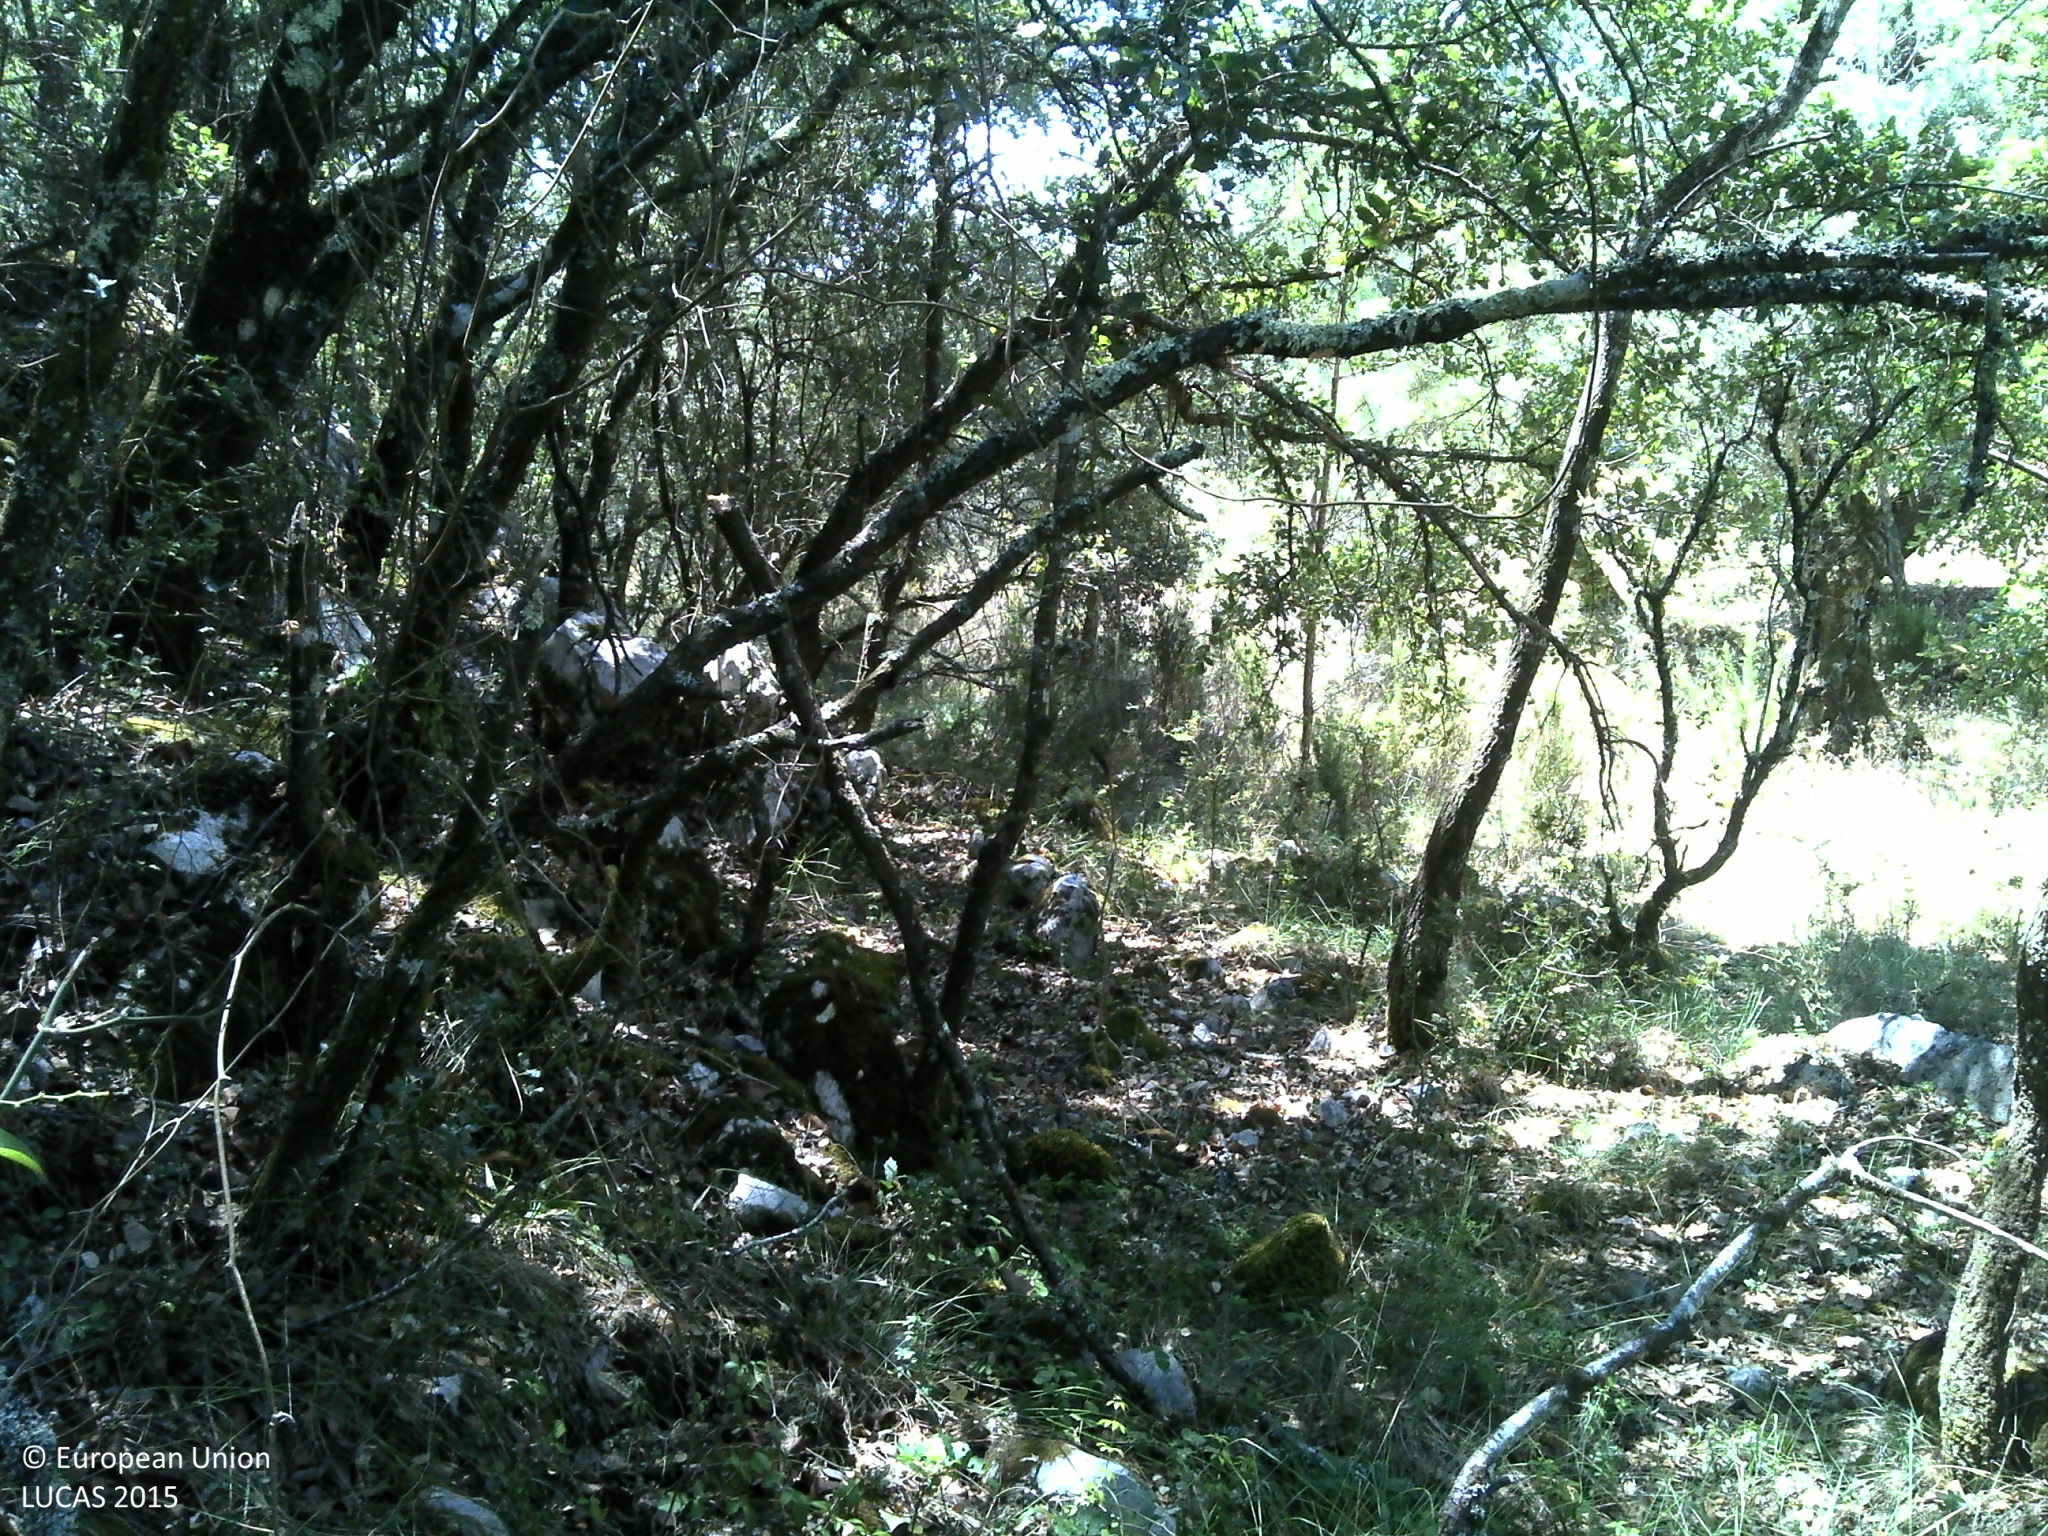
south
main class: Woodland
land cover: Broadleaved woodland
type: acidophilous oak and oak-birch forest
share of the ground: 50 - 75 %
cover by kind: broadleaved forest trees 55 %, herbaceous plants 30 %, unconsolidated bare surface 10 %, shrubs 5 %
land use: Forestry
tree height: > 5 m
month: July
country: PT
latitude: 39.8353
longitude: -8.4345
